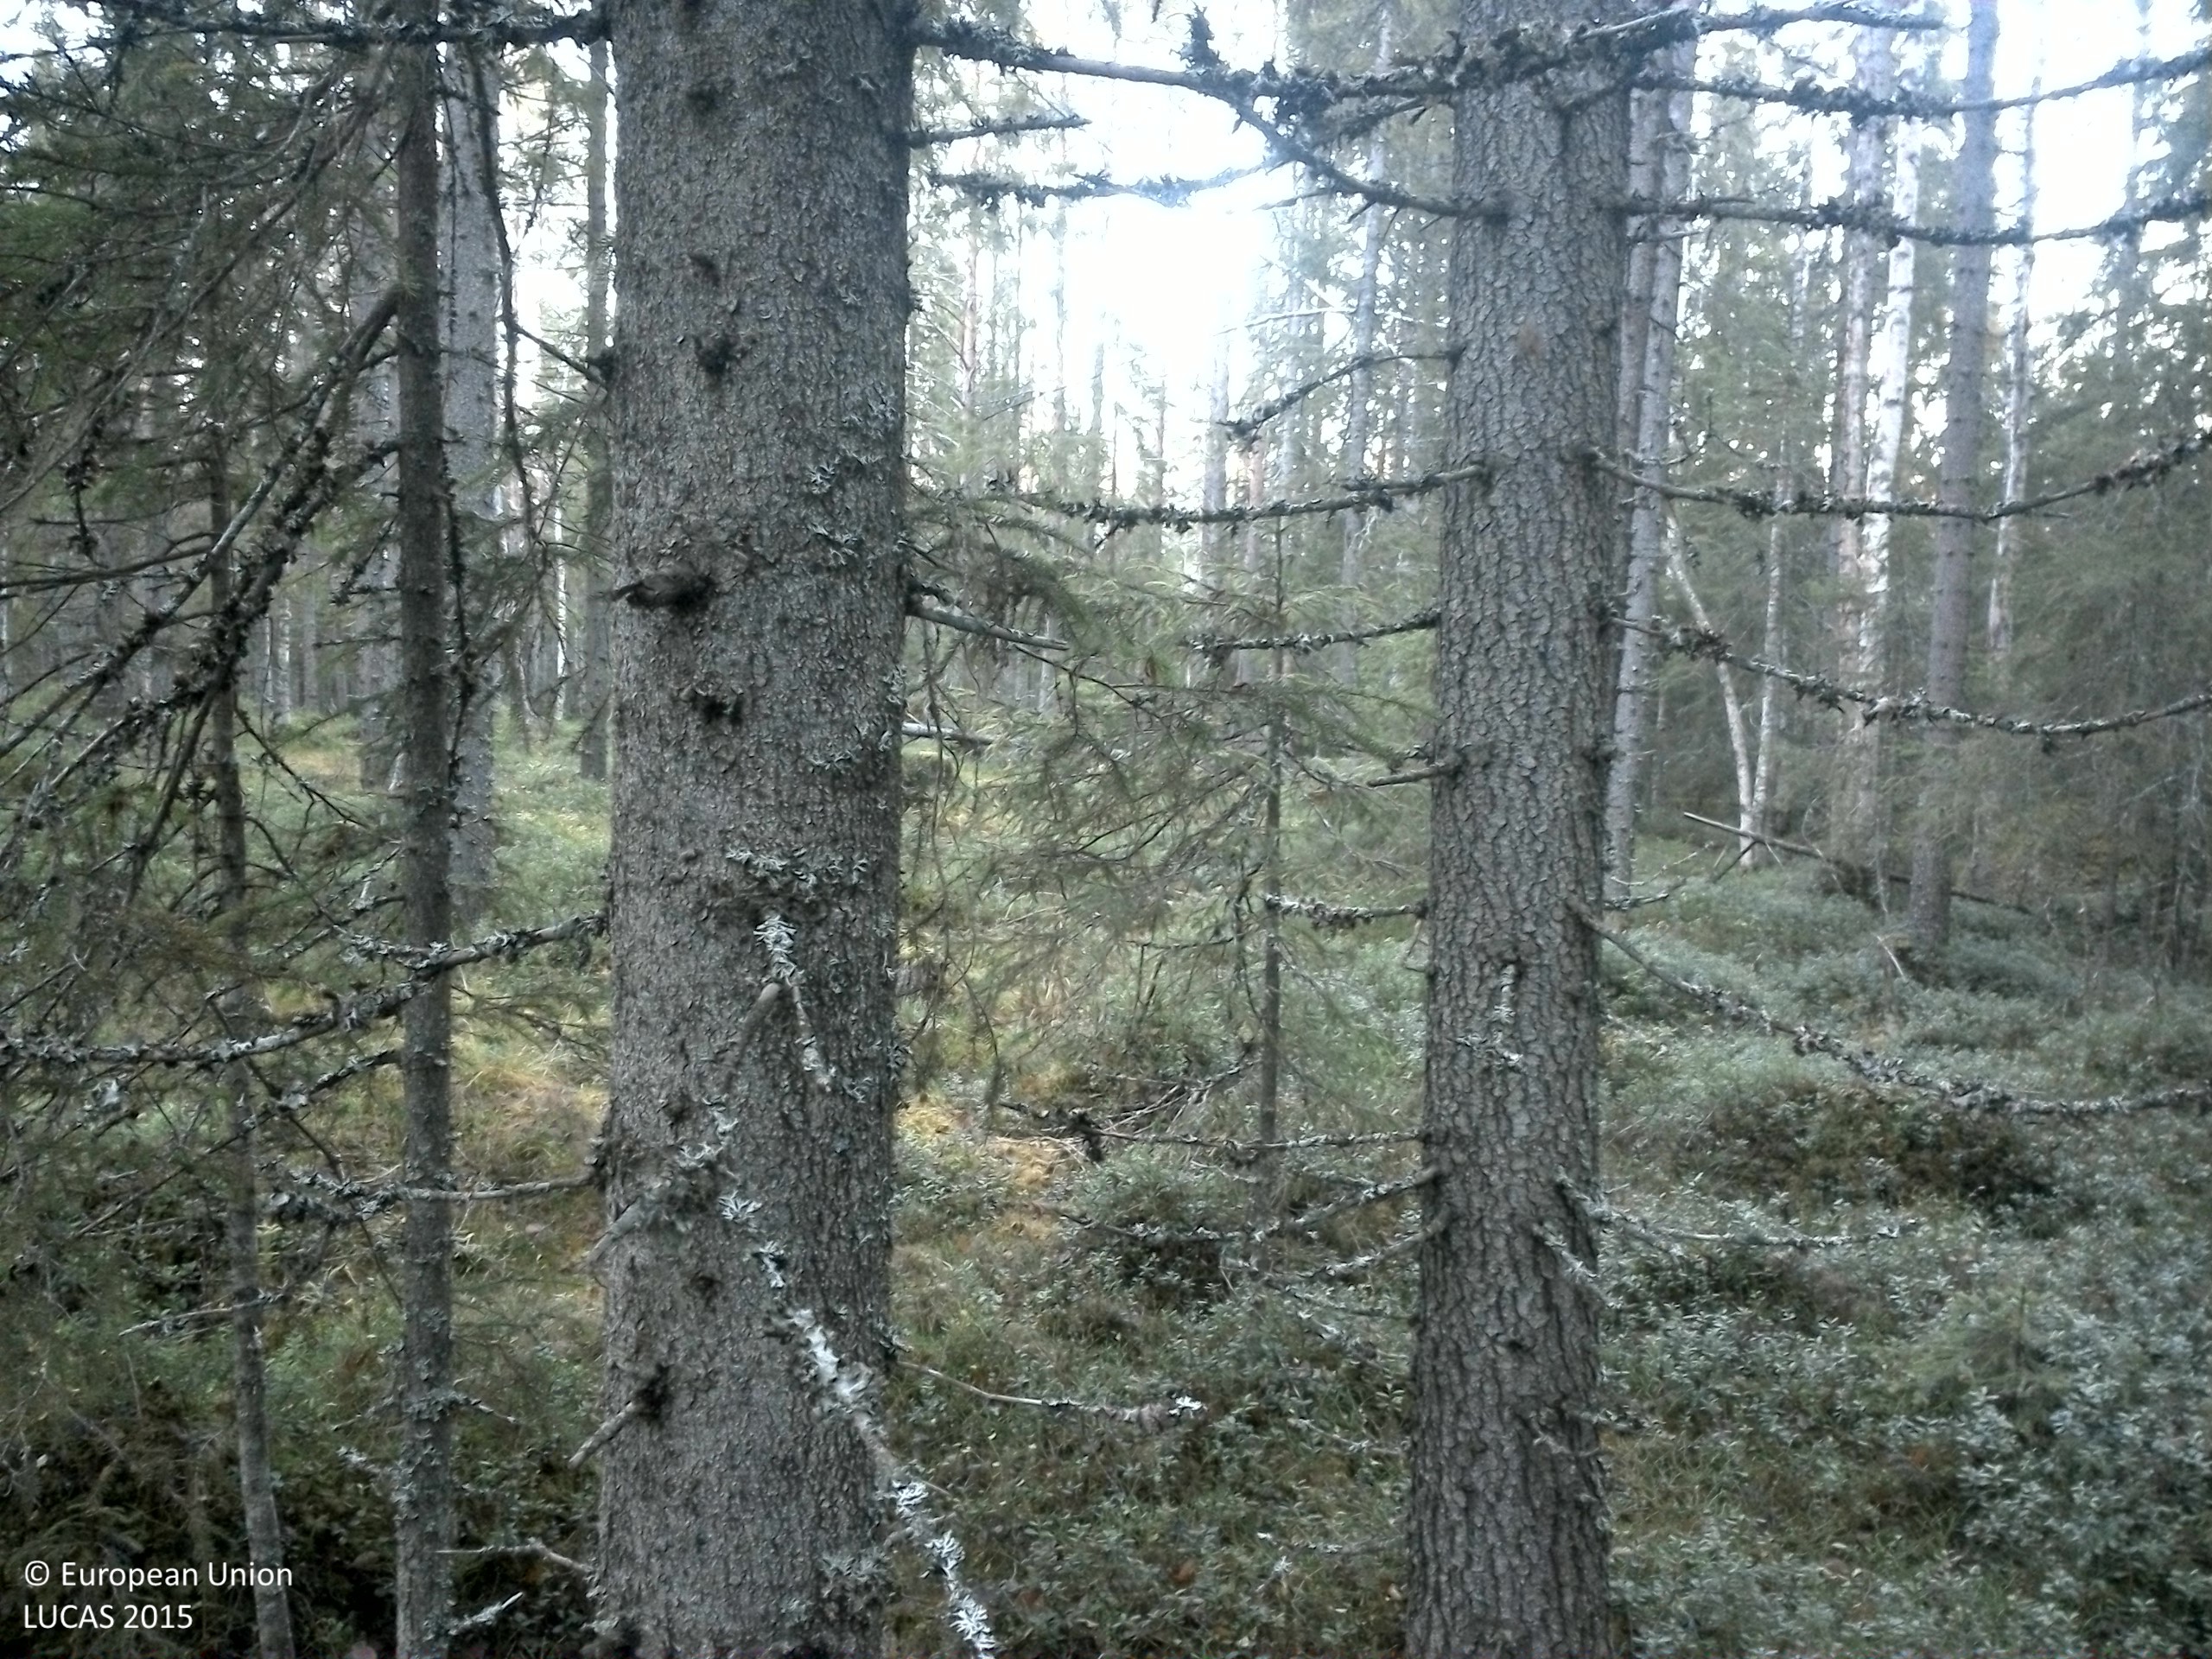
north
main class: Woodland
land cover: Spruce dominated coniferous woodland
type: boreal forest
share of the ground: 50 - 75 %
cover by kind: coniferous forest trees 55 %, shrubs 20 %, lichens and mosses 15 %, broadleaved forest trees 10 %
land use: Forestry
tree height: > 5 m
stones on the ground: < 10 %
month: October
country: SE
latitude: 63.9815
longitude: 15.8769
